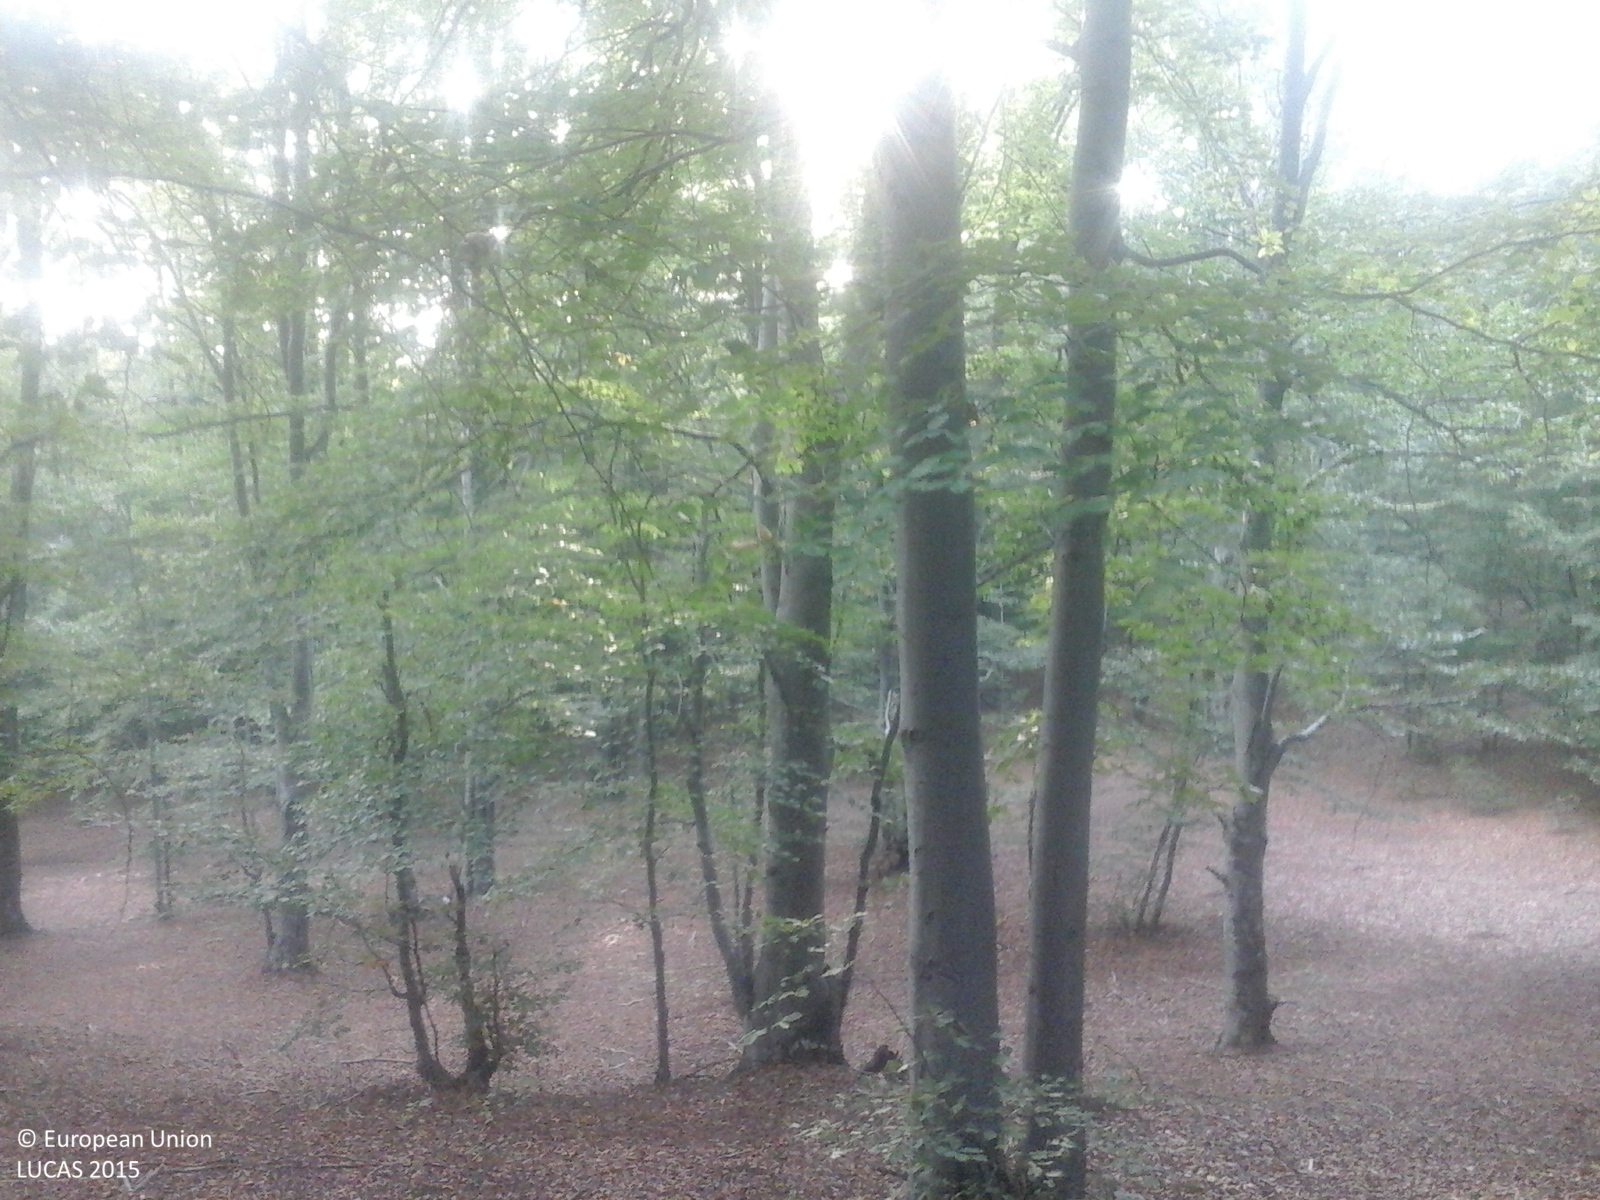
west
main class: Woodland
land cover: Broadleaved woodland
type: beech forest
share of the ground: > 75 %
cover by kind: broadleaved forest trees 100 %
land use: Forestry
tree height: > 5 m
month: September
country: RO
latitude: 47.0090
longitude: 22.7245
